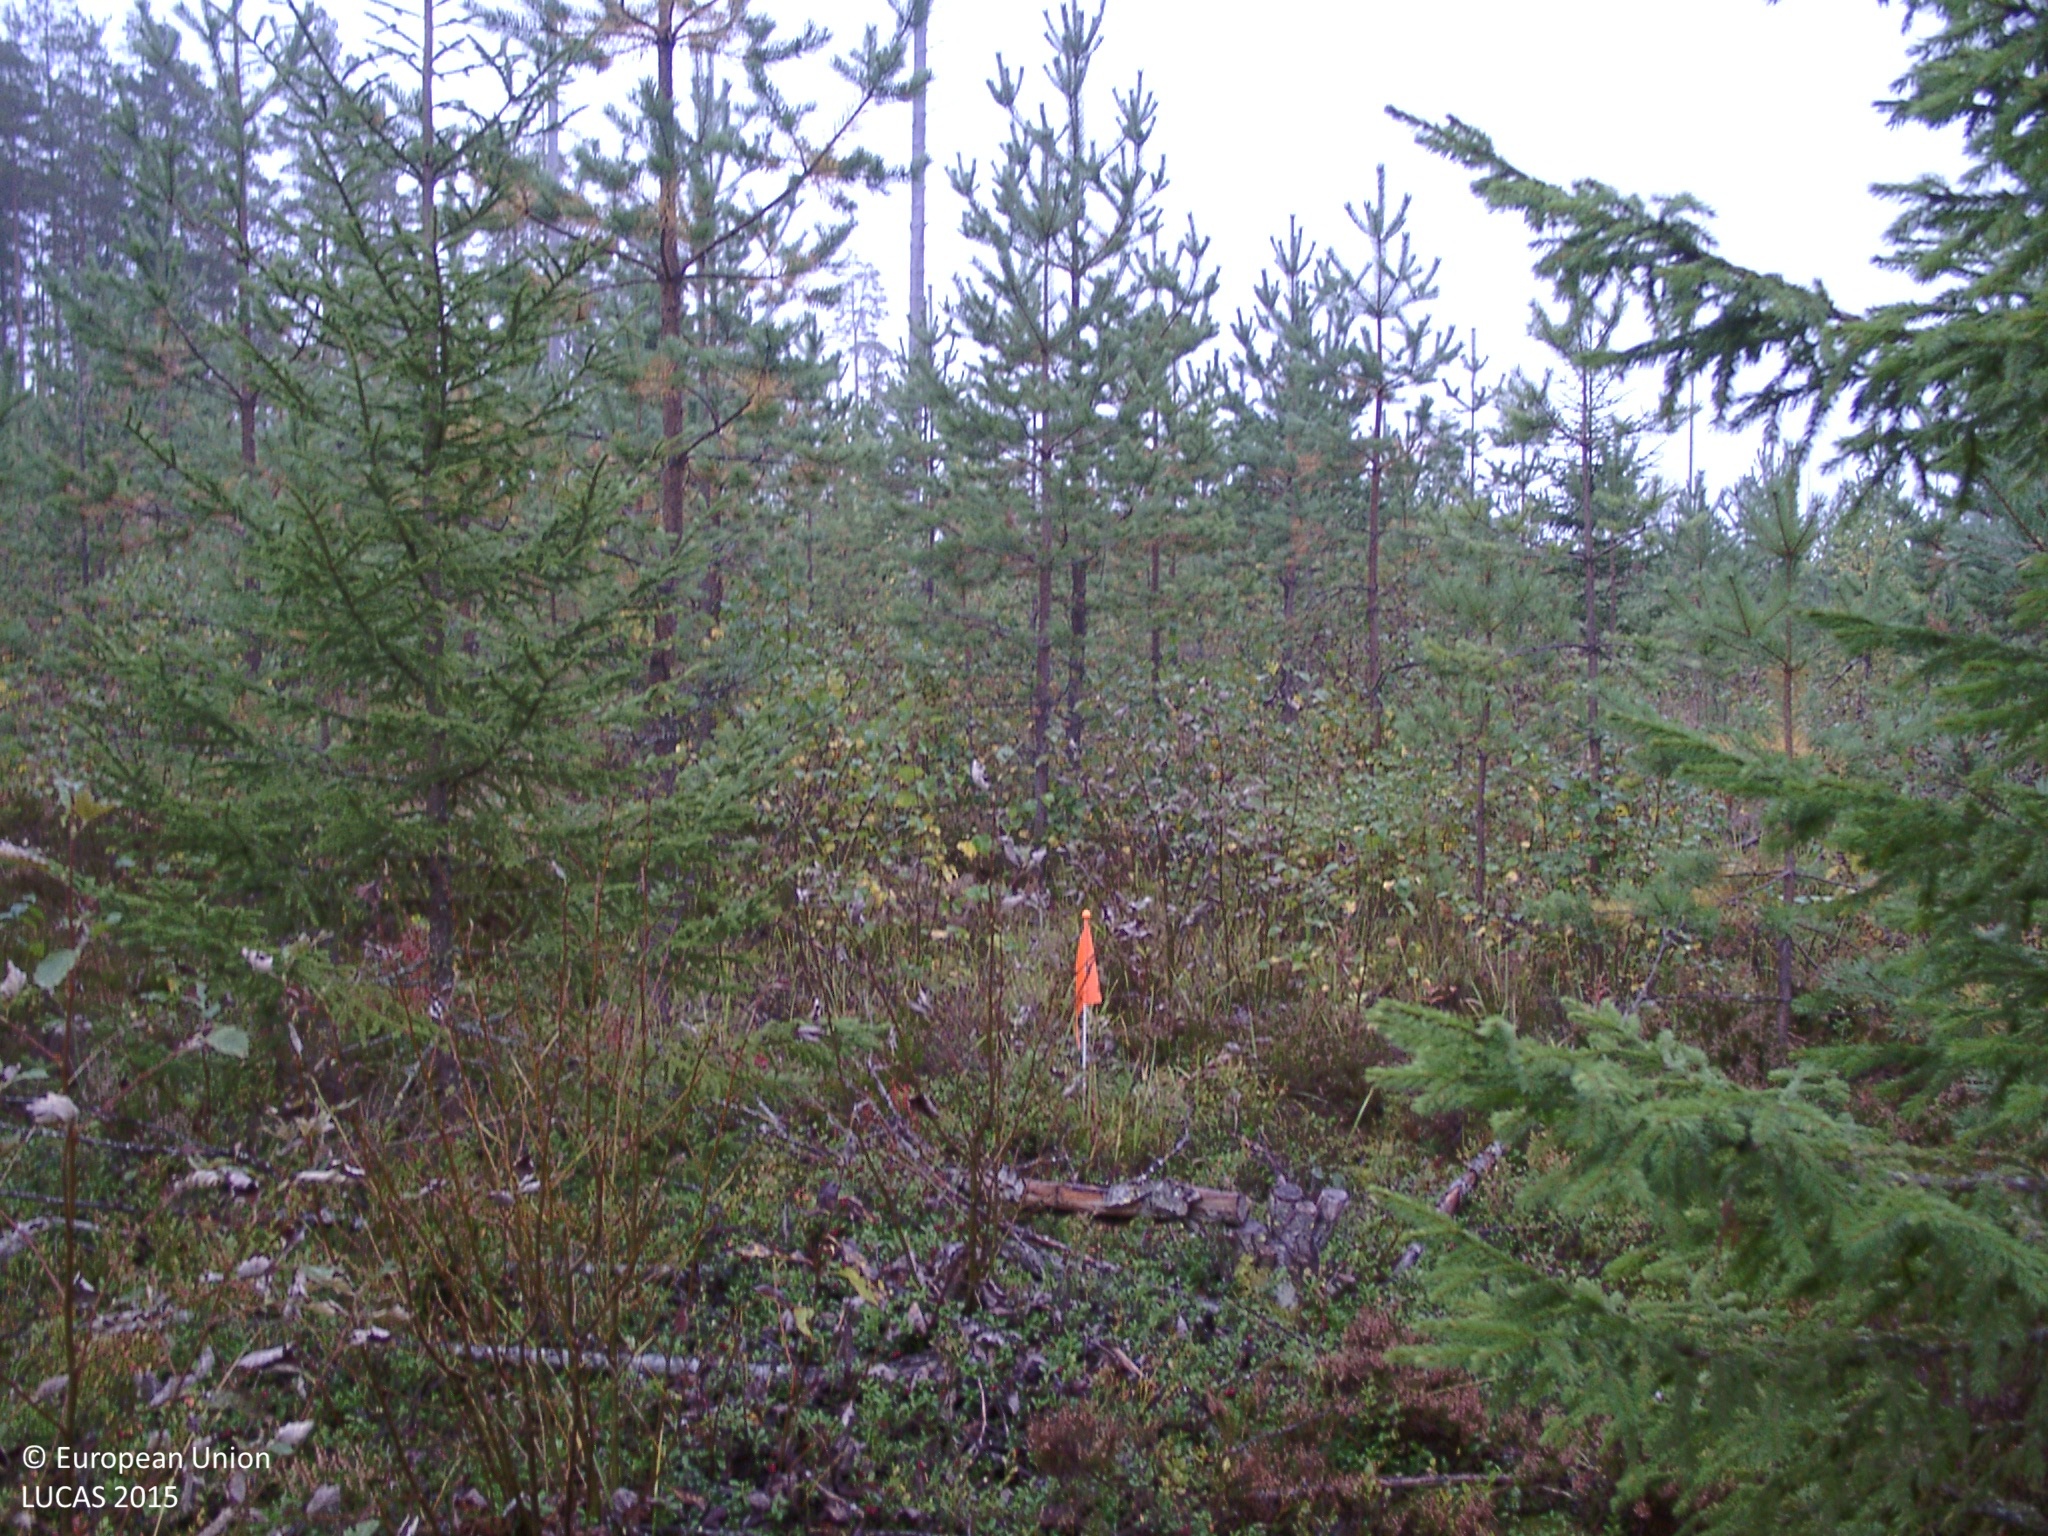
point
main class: Woodland
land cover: Pine dominated mixed woodland
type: boreal forest
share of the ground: 25 - 50 %
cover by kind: shrubs 35 %, coniferous forest trees 30 %, broadleaved forest trees 15 %, lichens and mosses 15 %, herbaceous plants 5 %
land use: Forestry
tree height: < 5 m
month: September
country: FI
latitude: 62.7086
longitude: 25.6550
